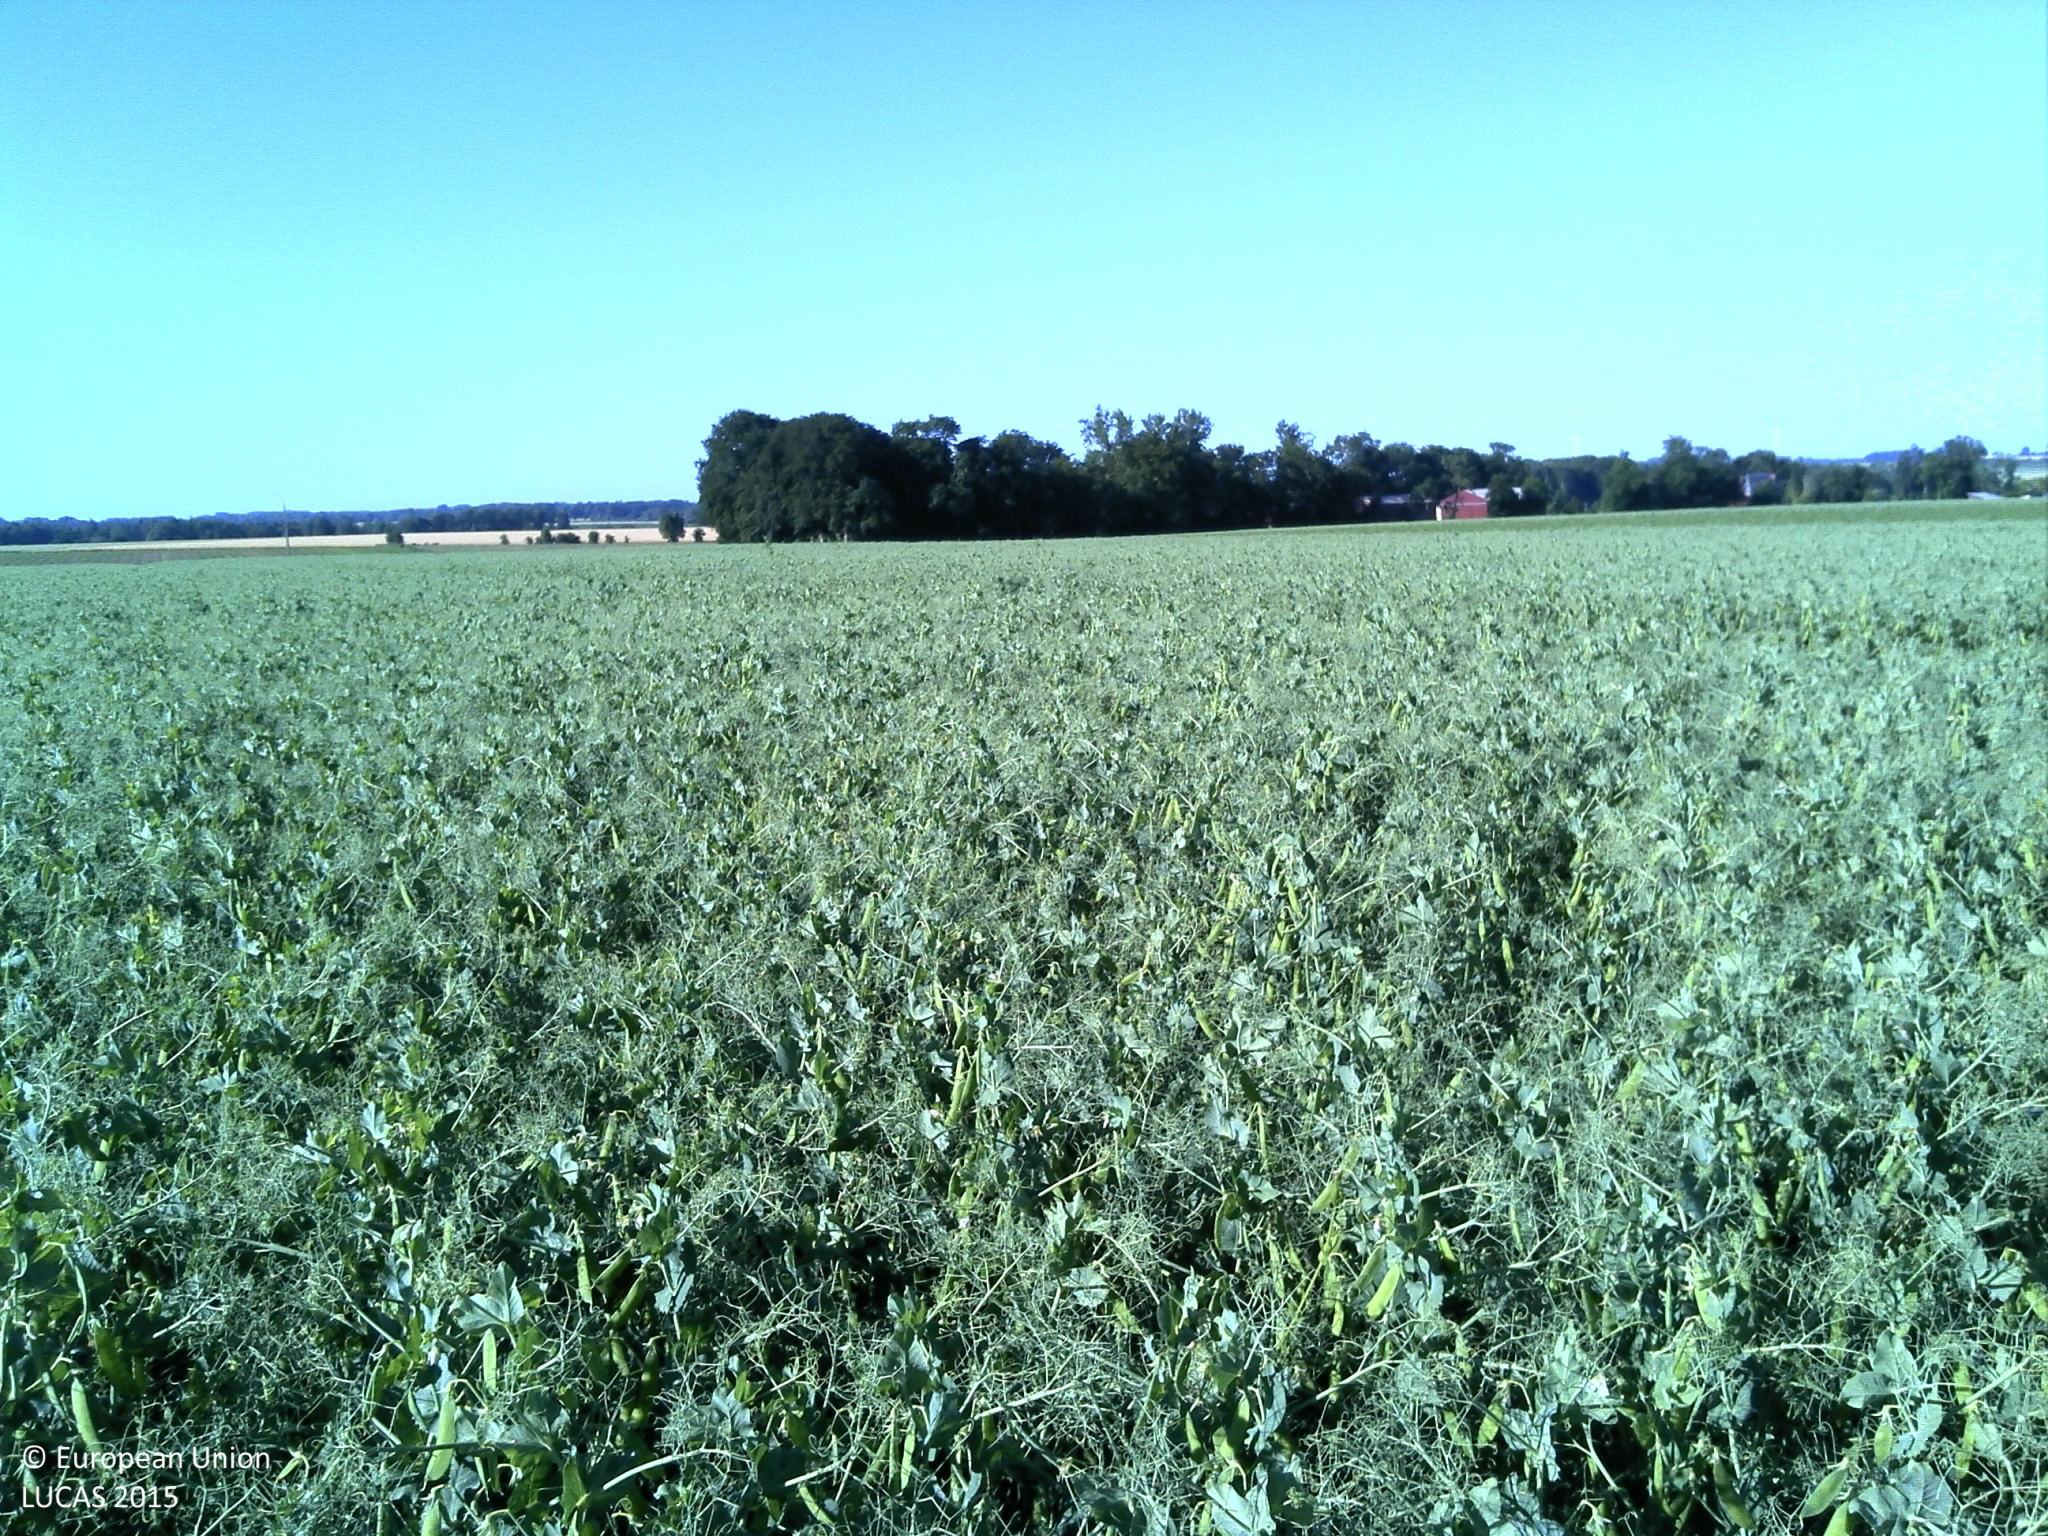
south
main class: Cropland
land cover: Dry pulses
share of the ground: > 75 %
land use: Agriculture (excluding fallow land and kitchen gardens)
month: June
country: FR
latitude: 49.7751
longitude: 1.0209
